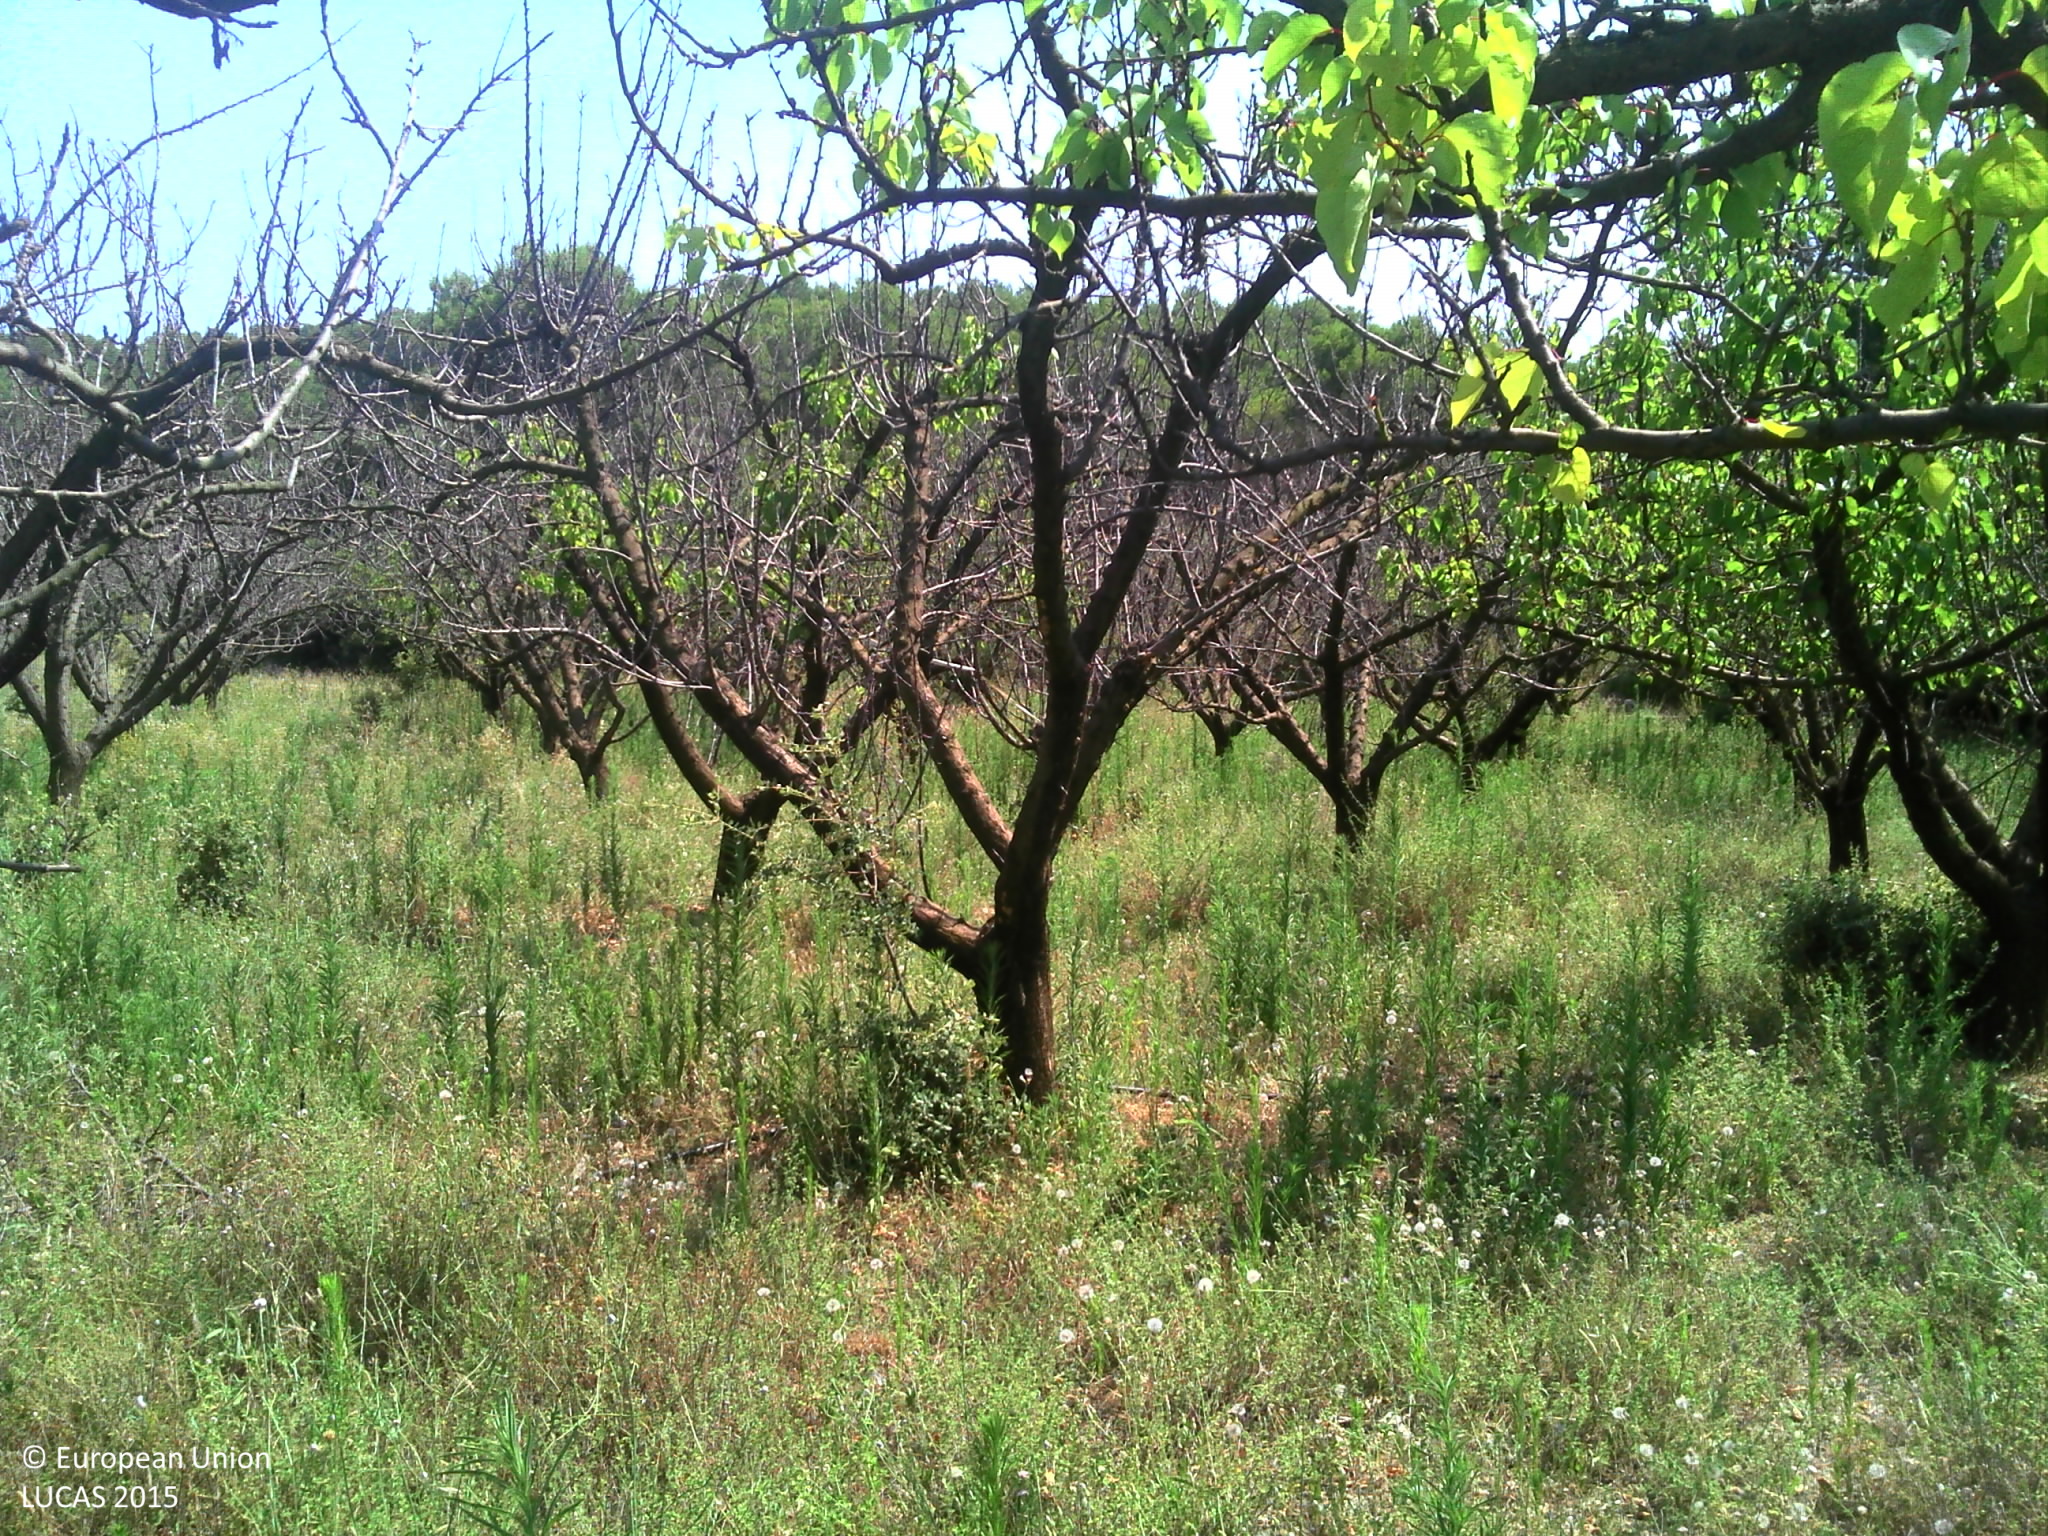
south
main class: Cropland
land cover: Other fruit trees and berries
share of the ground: 50 - 75 %
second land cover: Spontaneously vegetated surfaces
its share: 50 - 75 %
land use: Agriculture (excluding fallow land and kitchen gardens)
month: July
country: FR
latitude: 43.6751
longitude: 5.1101
